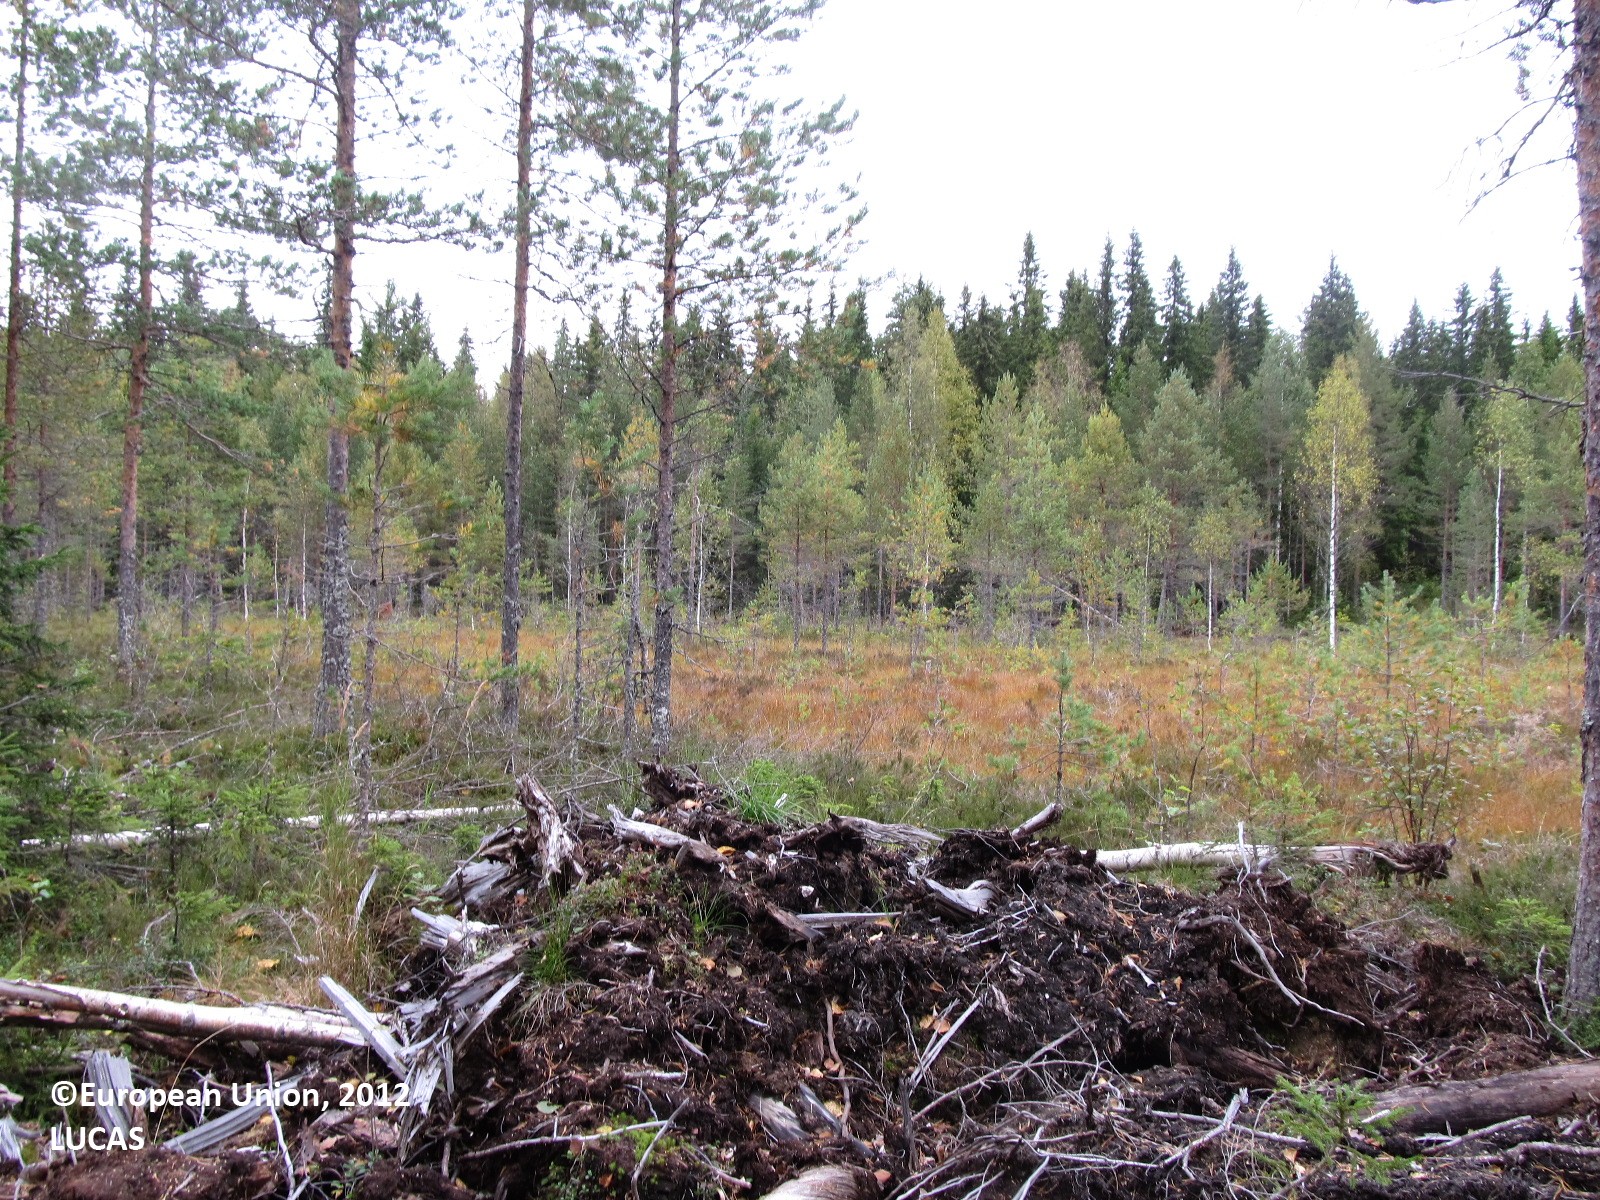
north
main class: Woodland
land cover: Pine dominated coniferous woodland
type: boreal forest
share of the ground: 25 - 50 %
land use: Forestry
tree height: > 5 m
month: September
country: FI
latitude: 63.0653
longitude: 28.5394
